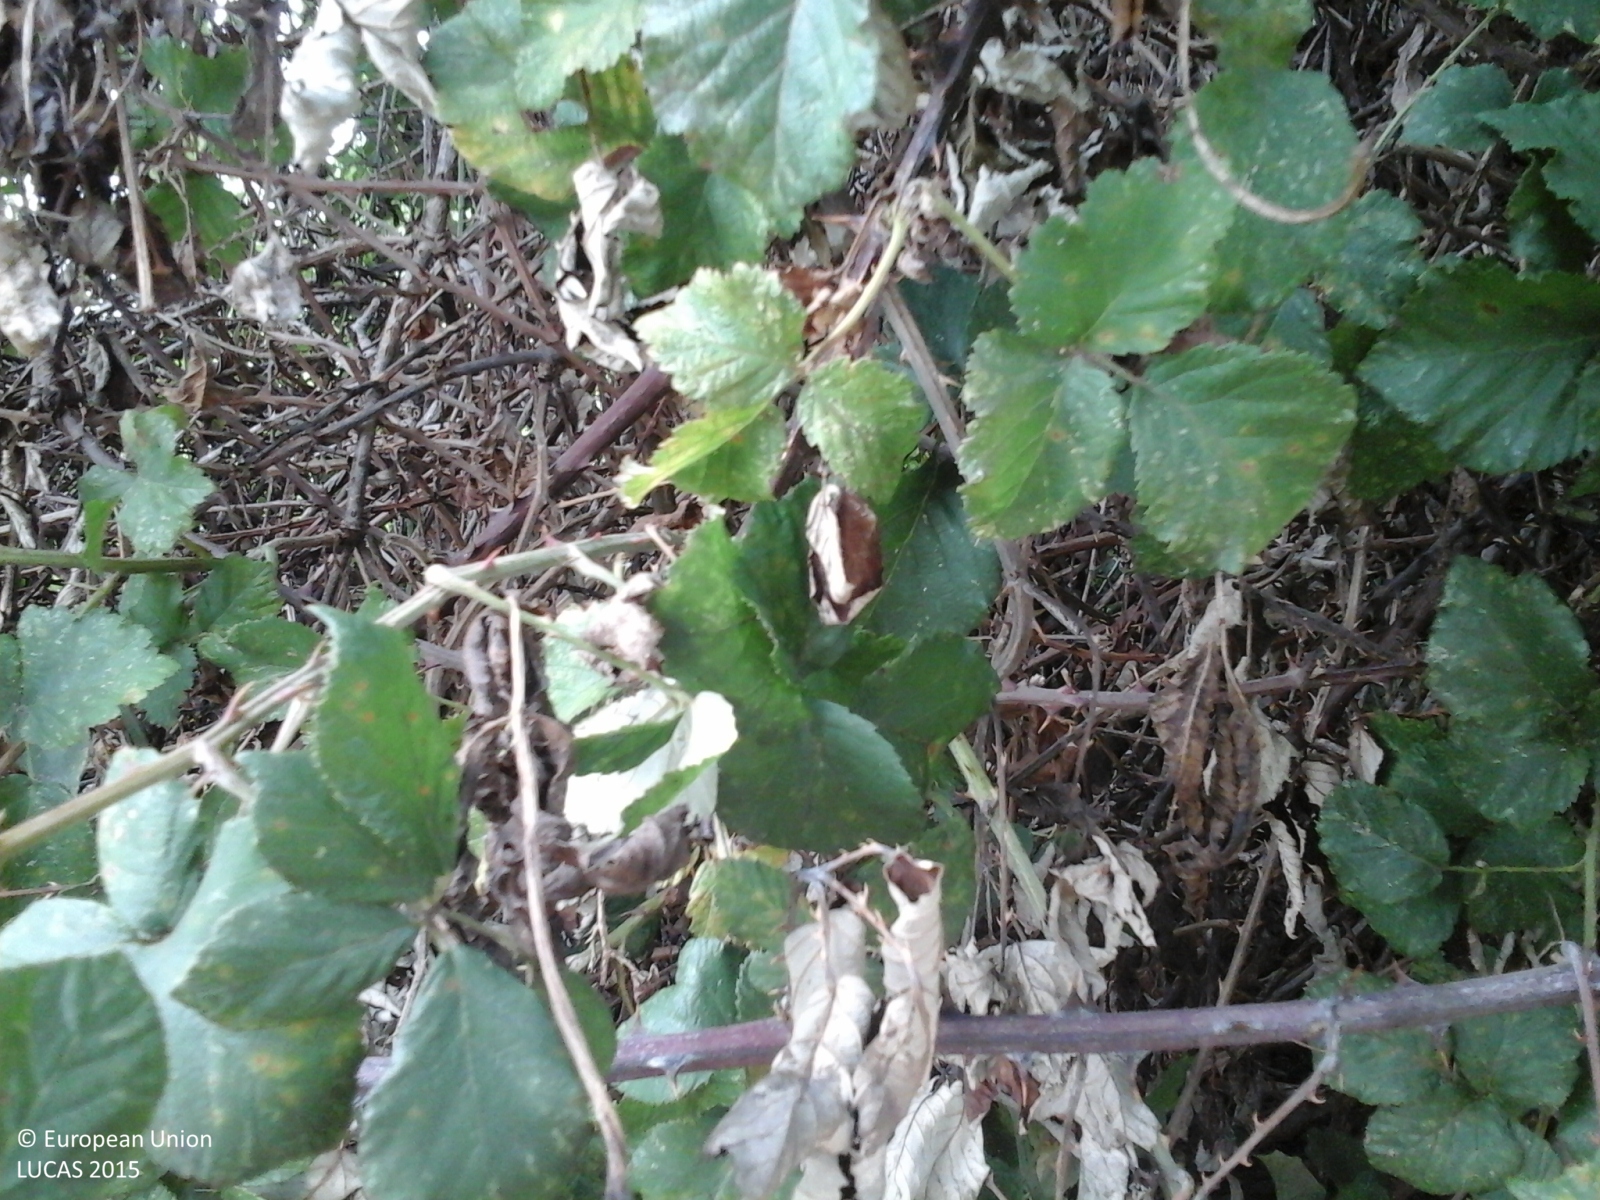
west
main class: Woodland
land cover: Broadleaved woodland
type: thermophilous deciduous forest
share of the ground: 50 - 75 %
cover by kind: broadleaved forest trees 95 %, shrubs 5 %
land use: Forestry
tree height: > 5 m
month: August
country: IT
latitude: 43.3462
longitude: 13.1376
